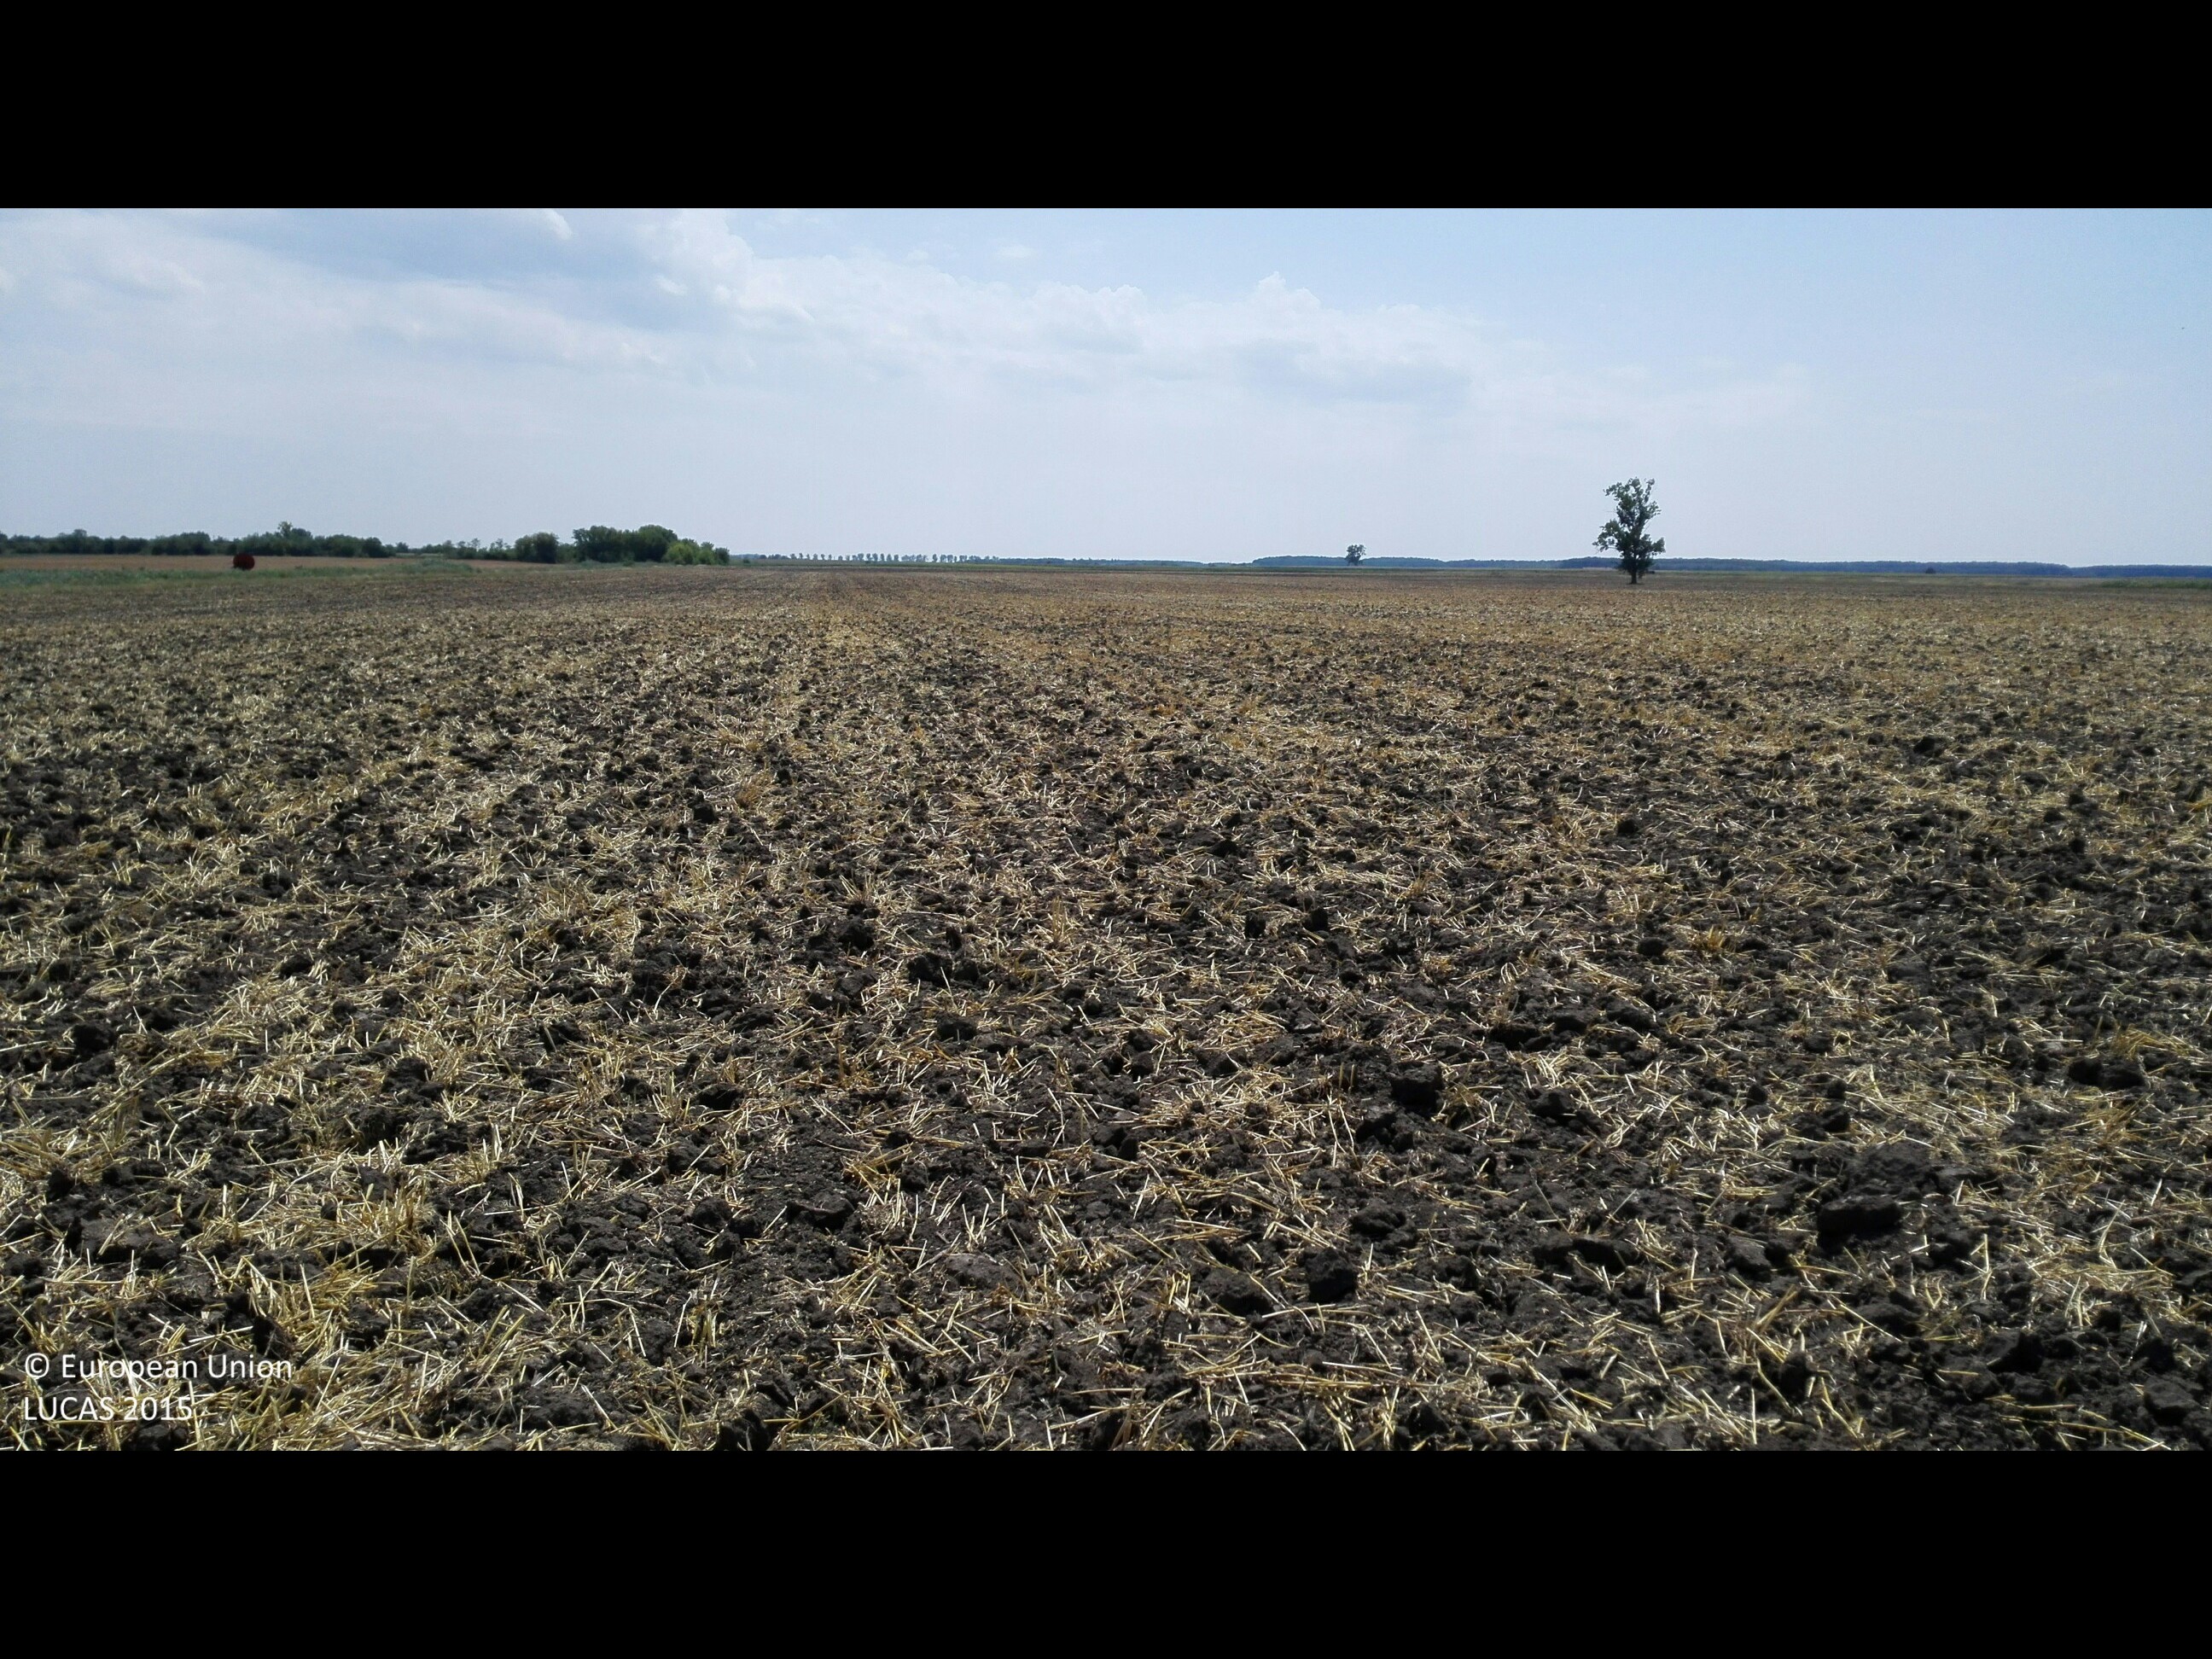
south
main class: Cropland
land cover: Barley
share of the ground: < 10 %
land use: Agriculture (excluding fallow land and kitchen gardens)
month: July
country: HU
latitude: 47.2400
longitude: 21.3075
